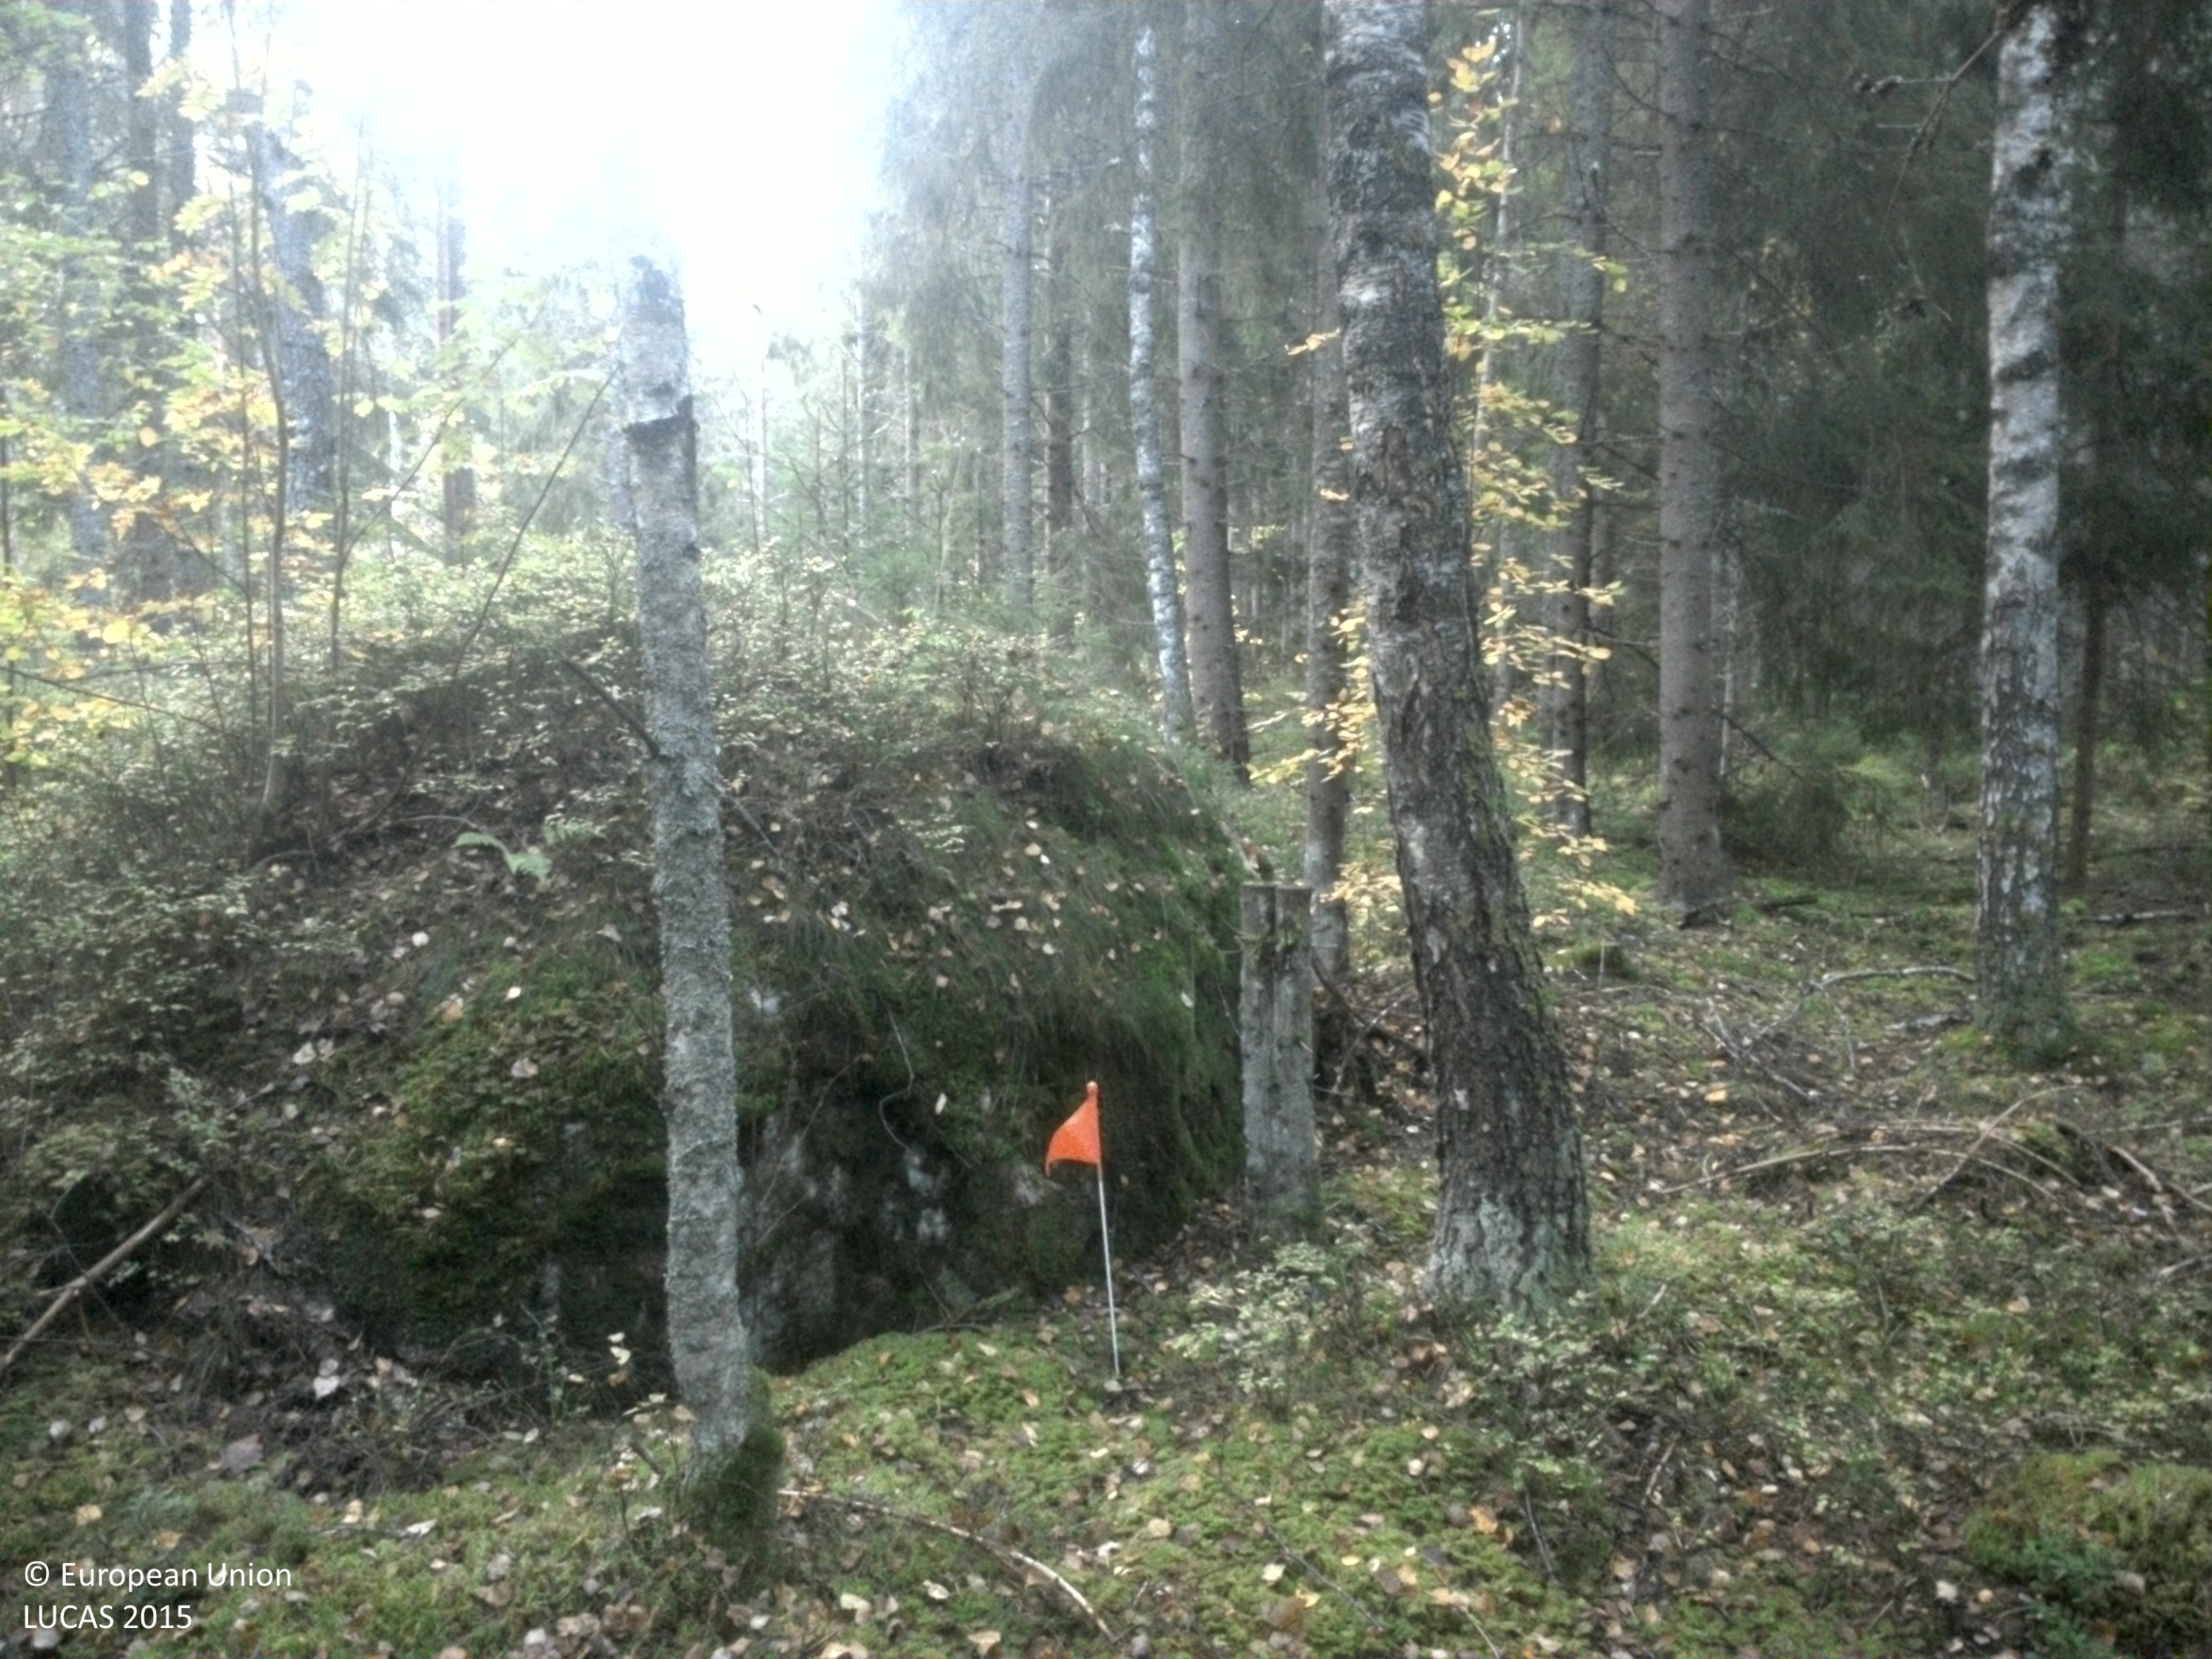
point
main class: Woodland
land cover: Spruce dominated mixed woodland
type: boreal forest
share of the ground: 50 - 75 %
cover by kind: coniferous forest trees 40 %, broadleaved forest trees 30 %, lichens and mosses 20 %, shrubs 10 %
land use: Forestry
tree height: > 5 m
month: September
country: SE
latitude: 59.5778
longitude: 15.2491
